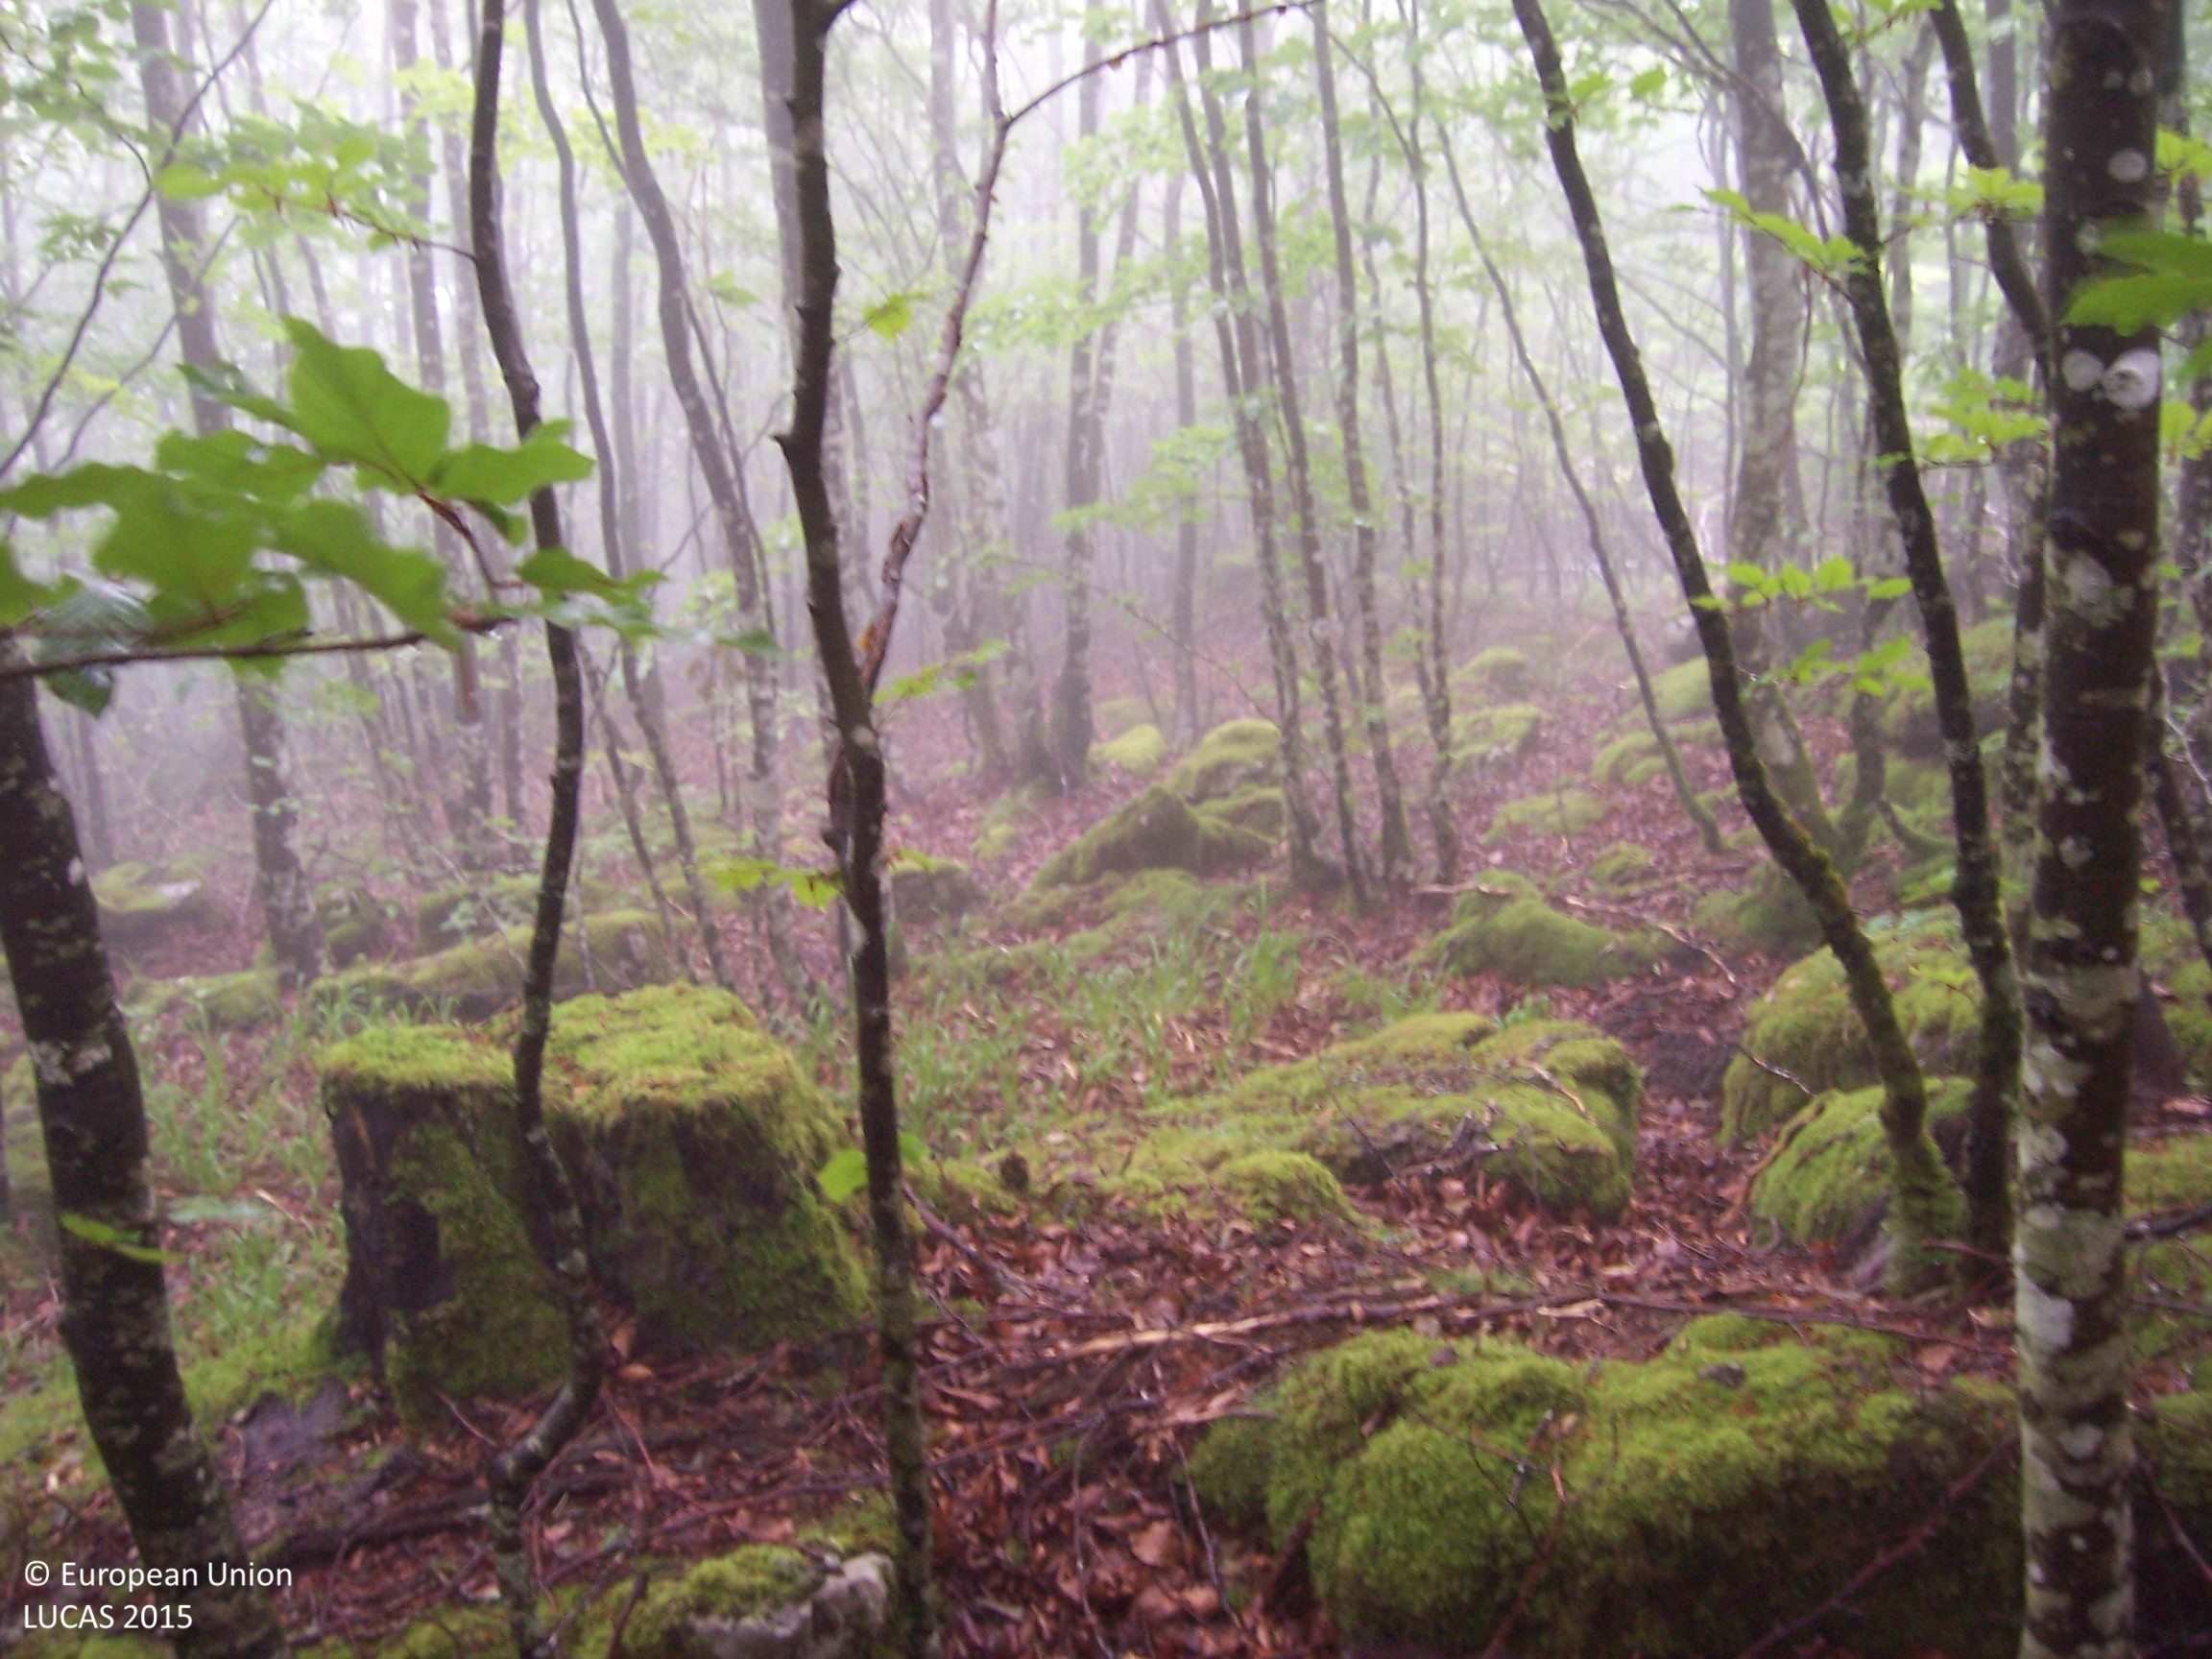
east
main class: Woodland
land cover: Broadleaved woodland
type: mountainous beech forest
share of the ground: > 75 %
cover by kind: broadleaved forest trees 100 %
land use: Forestry
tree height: > 5 m
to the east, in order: Broadleaved woodland; Fences; Grassland without tree/shrub cover
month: July
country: ES
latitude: 43.0483
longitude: -1.2206
